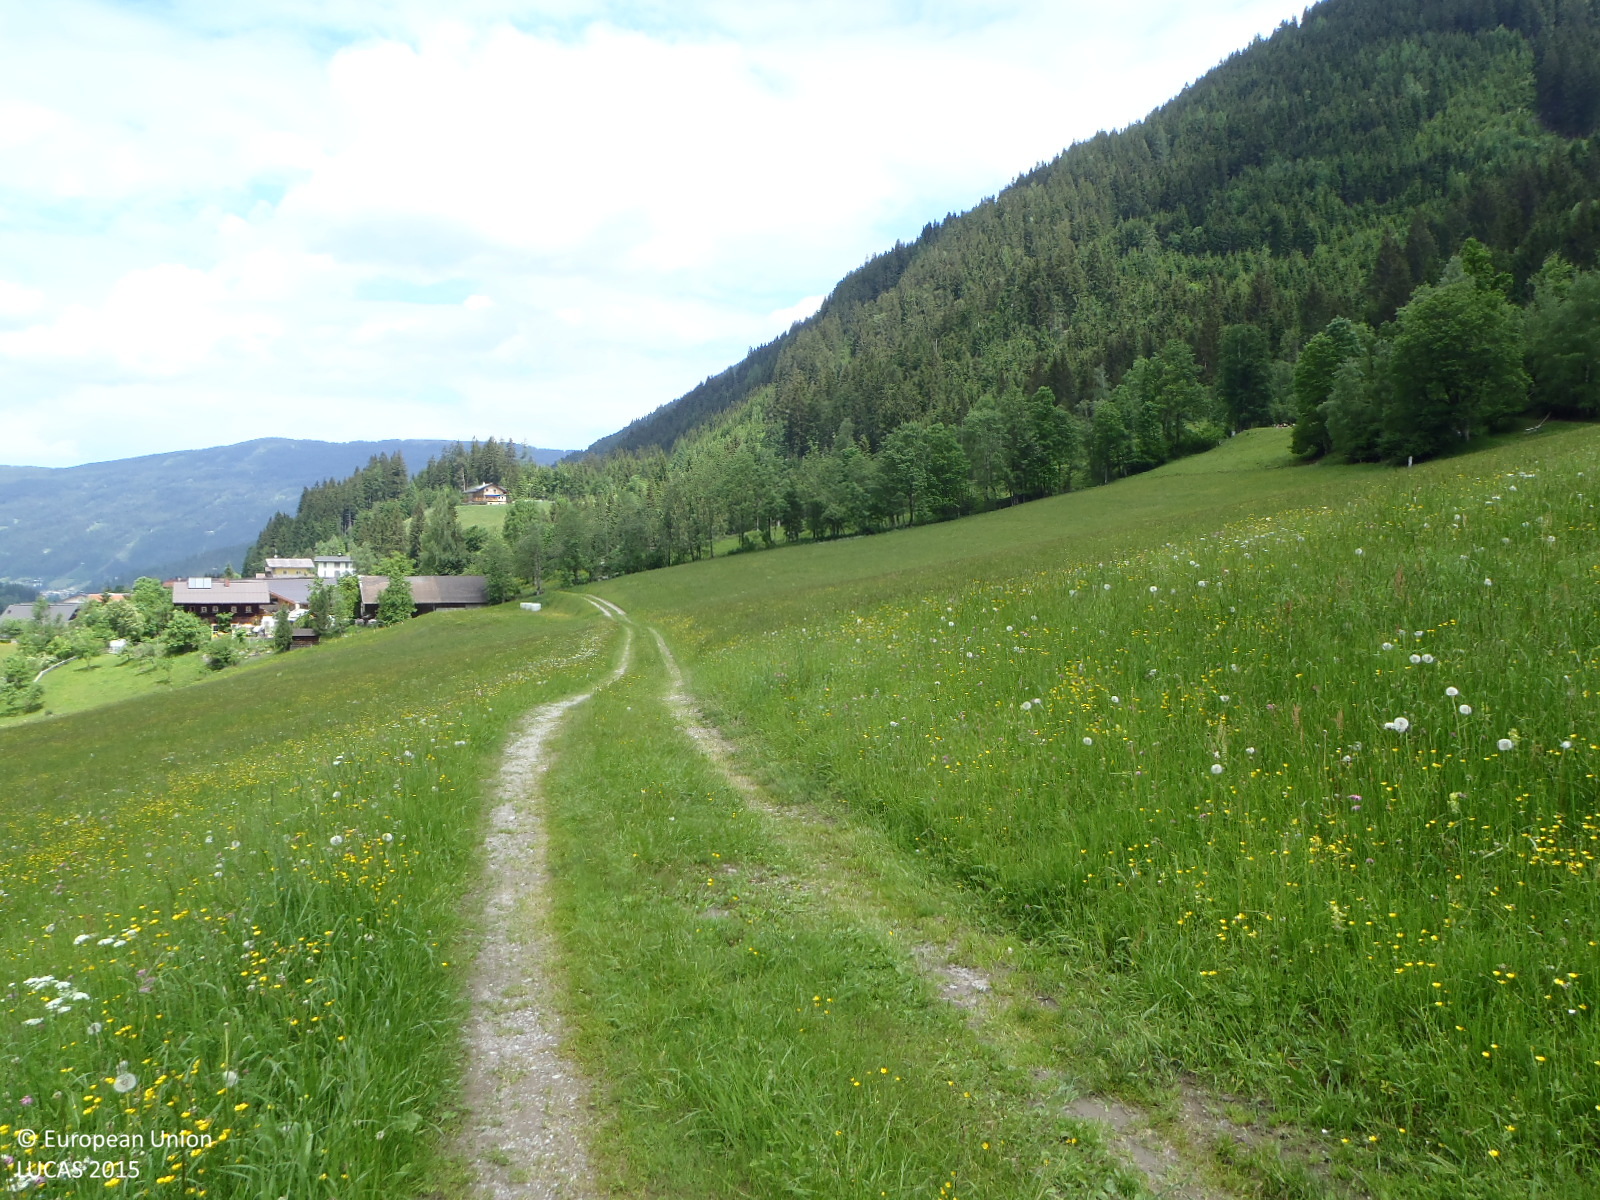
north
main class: Grassland
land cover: Grassland without tree/shrub cover
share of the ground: > 75 %
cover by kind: herbaceous plants 100 %
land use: Agriculture (excluding fallow land and kitchen gardens)
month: June
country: AT
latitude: 47.3391
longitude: 13.5054
